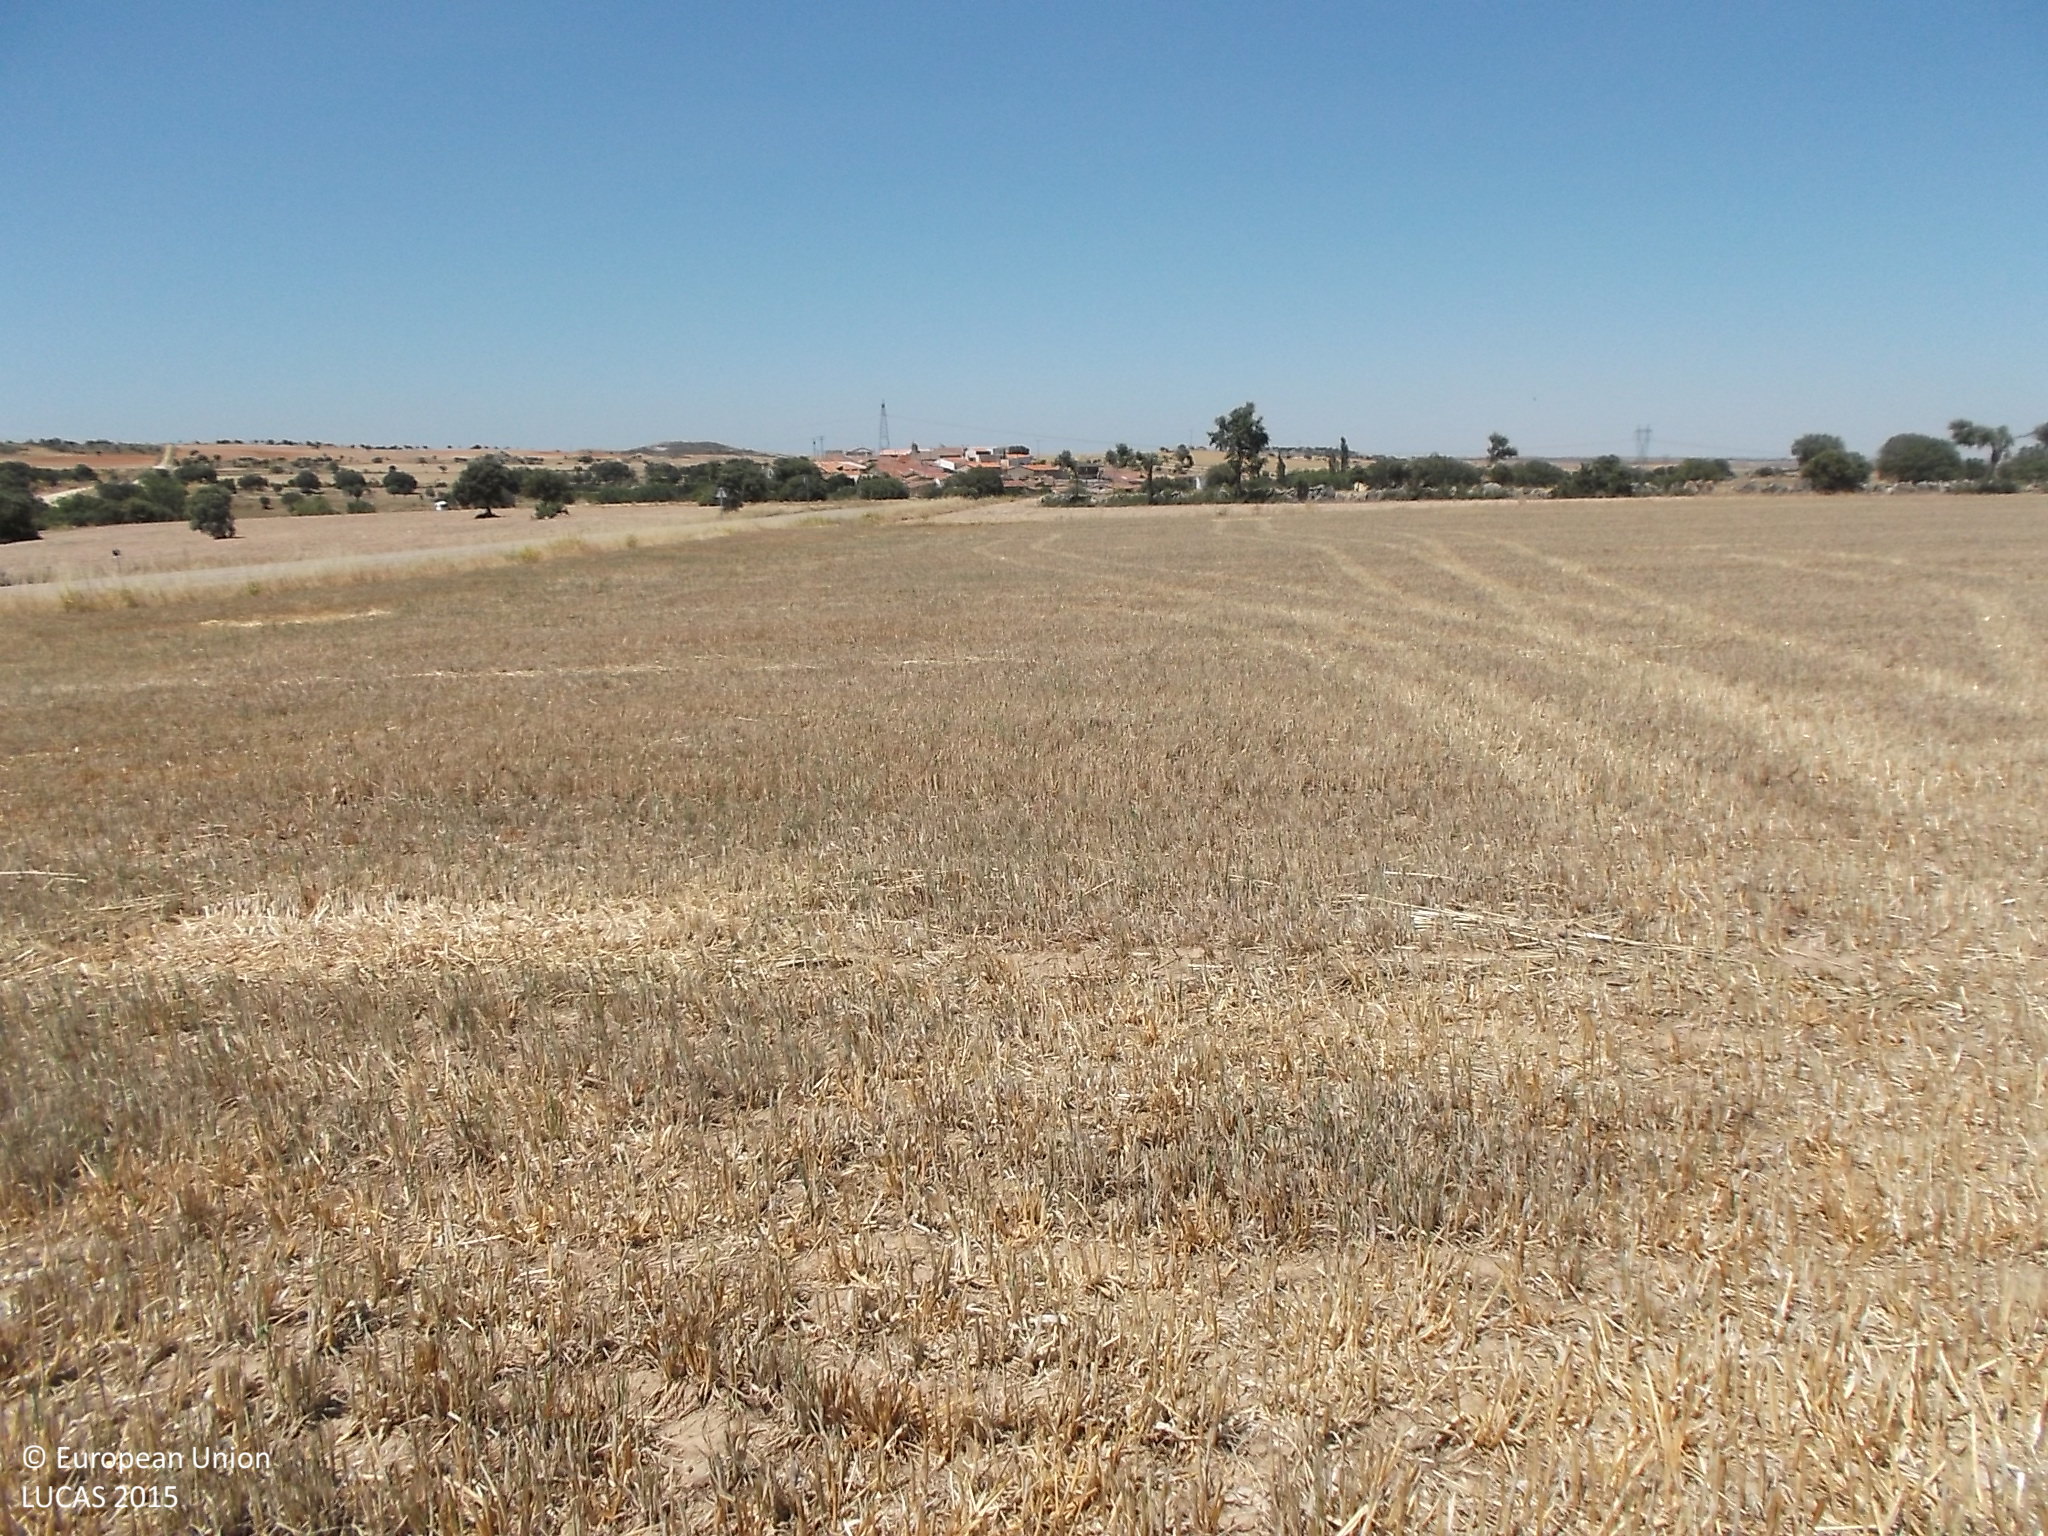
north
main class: Cropland
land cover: Oats
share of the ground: < 10 %
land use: Agriculture (excluding fallow land and kitchen gardens)
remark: Harvested field
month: July
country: ES
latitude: 41.3770
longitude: -5.8581
